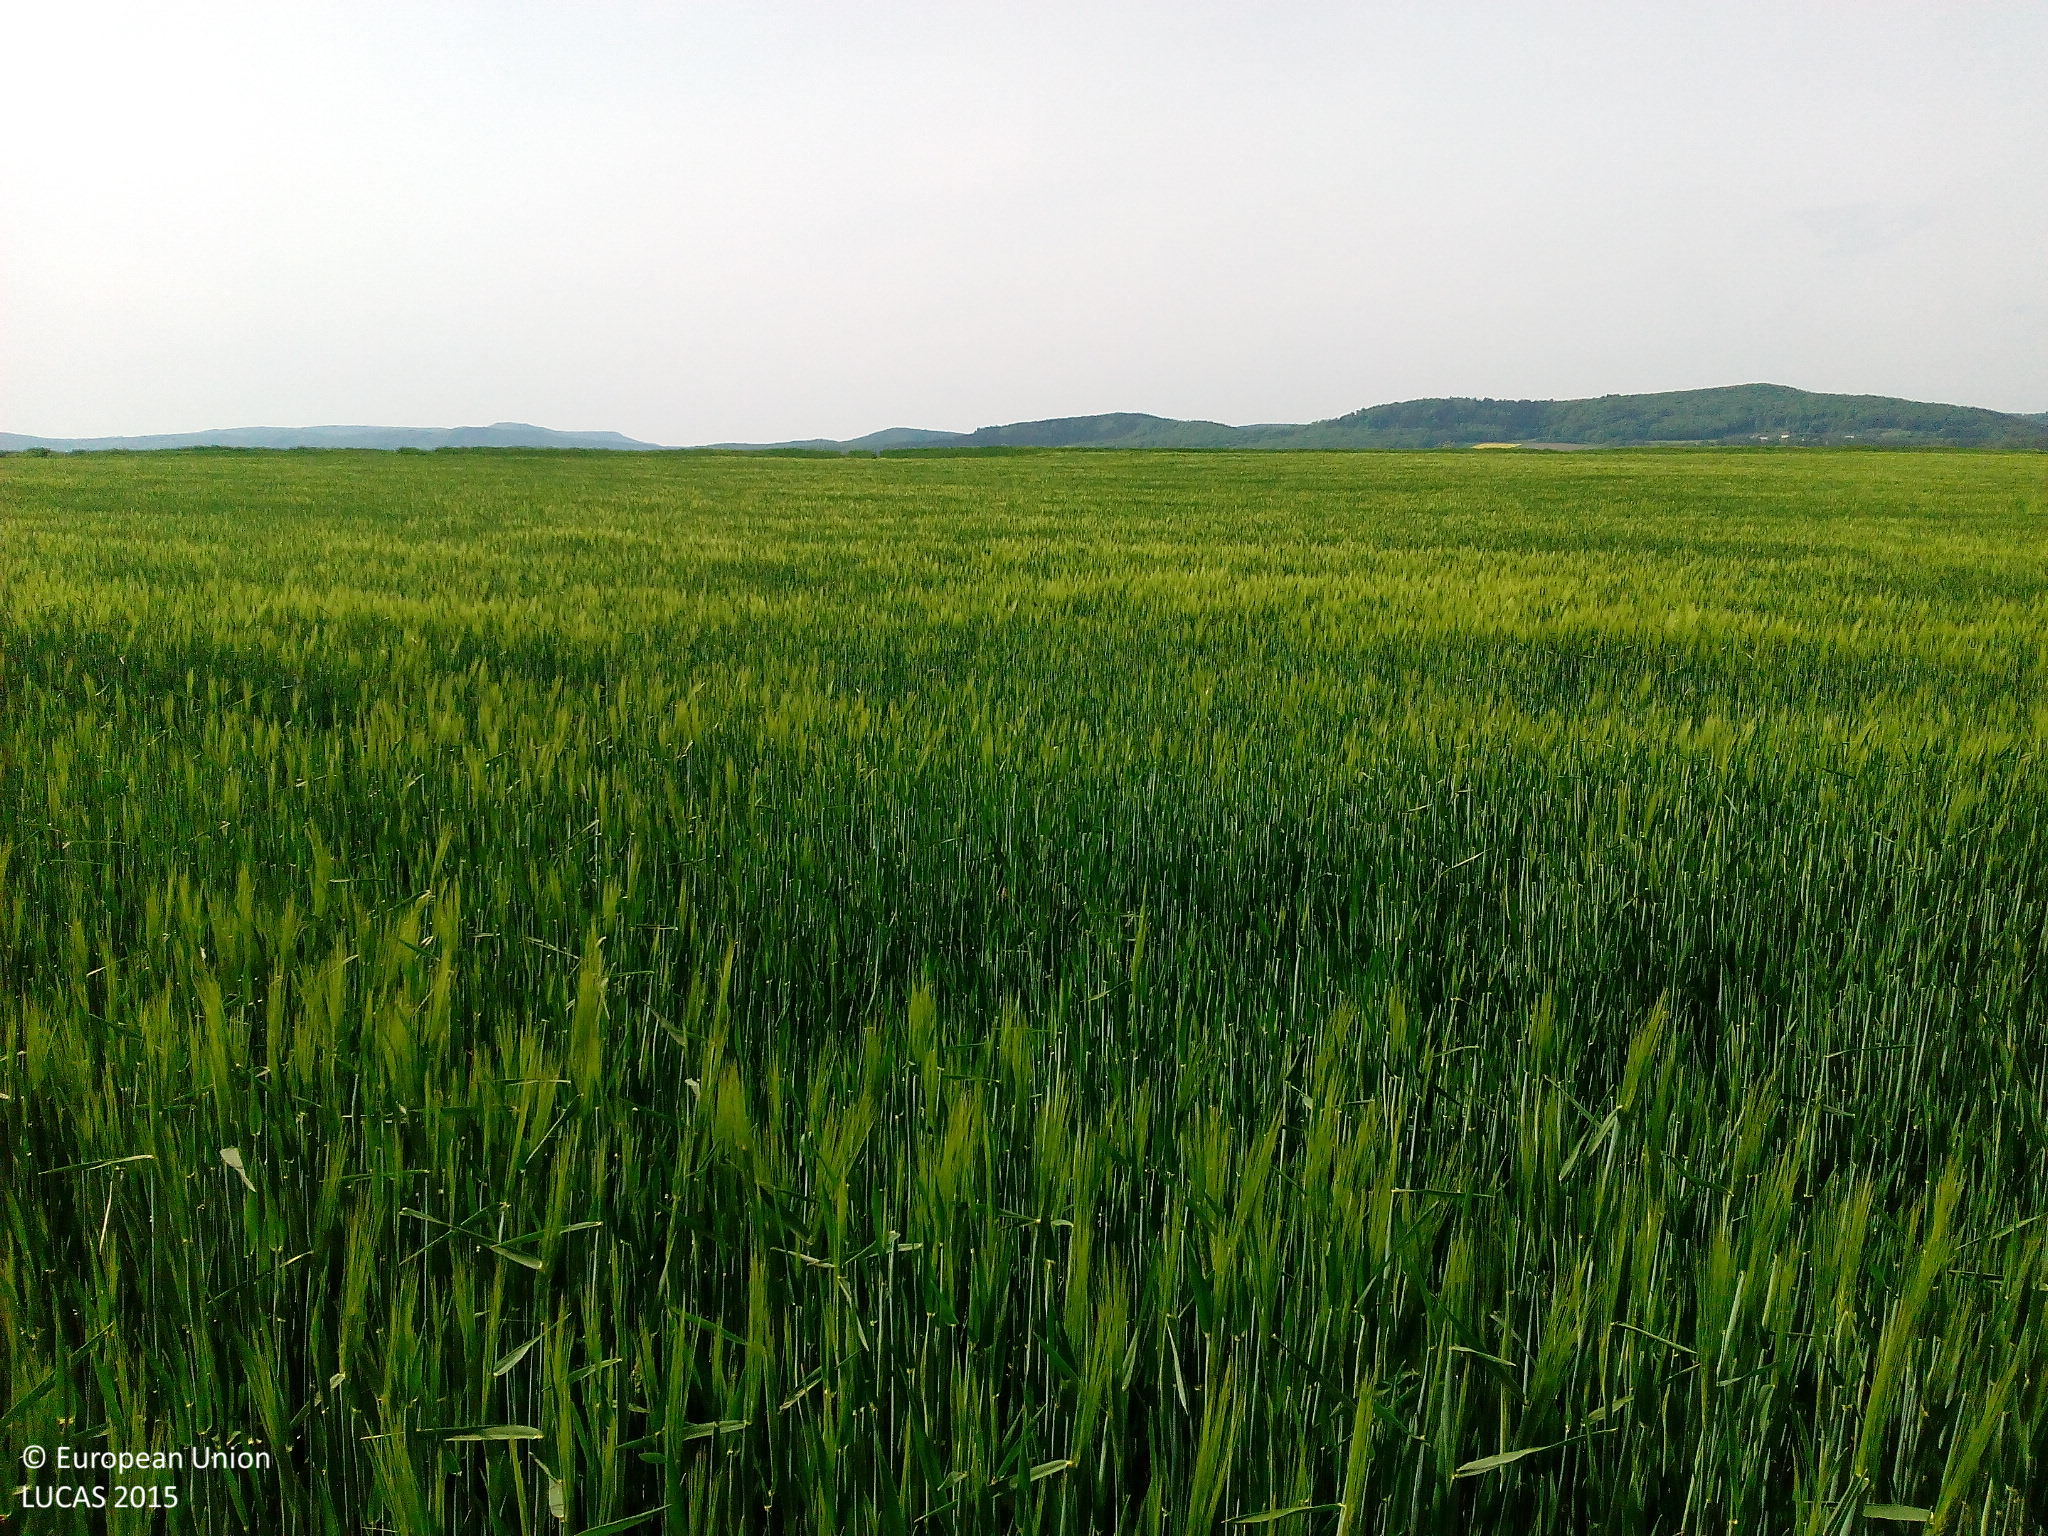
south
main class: Cropland
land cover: Barley
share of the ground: > 75 %
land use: Agriculture (excluding fallow land and kitchen gardens)
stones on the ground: < 10 %
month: May
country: DE
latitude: 51.2090
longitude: 9.9571
